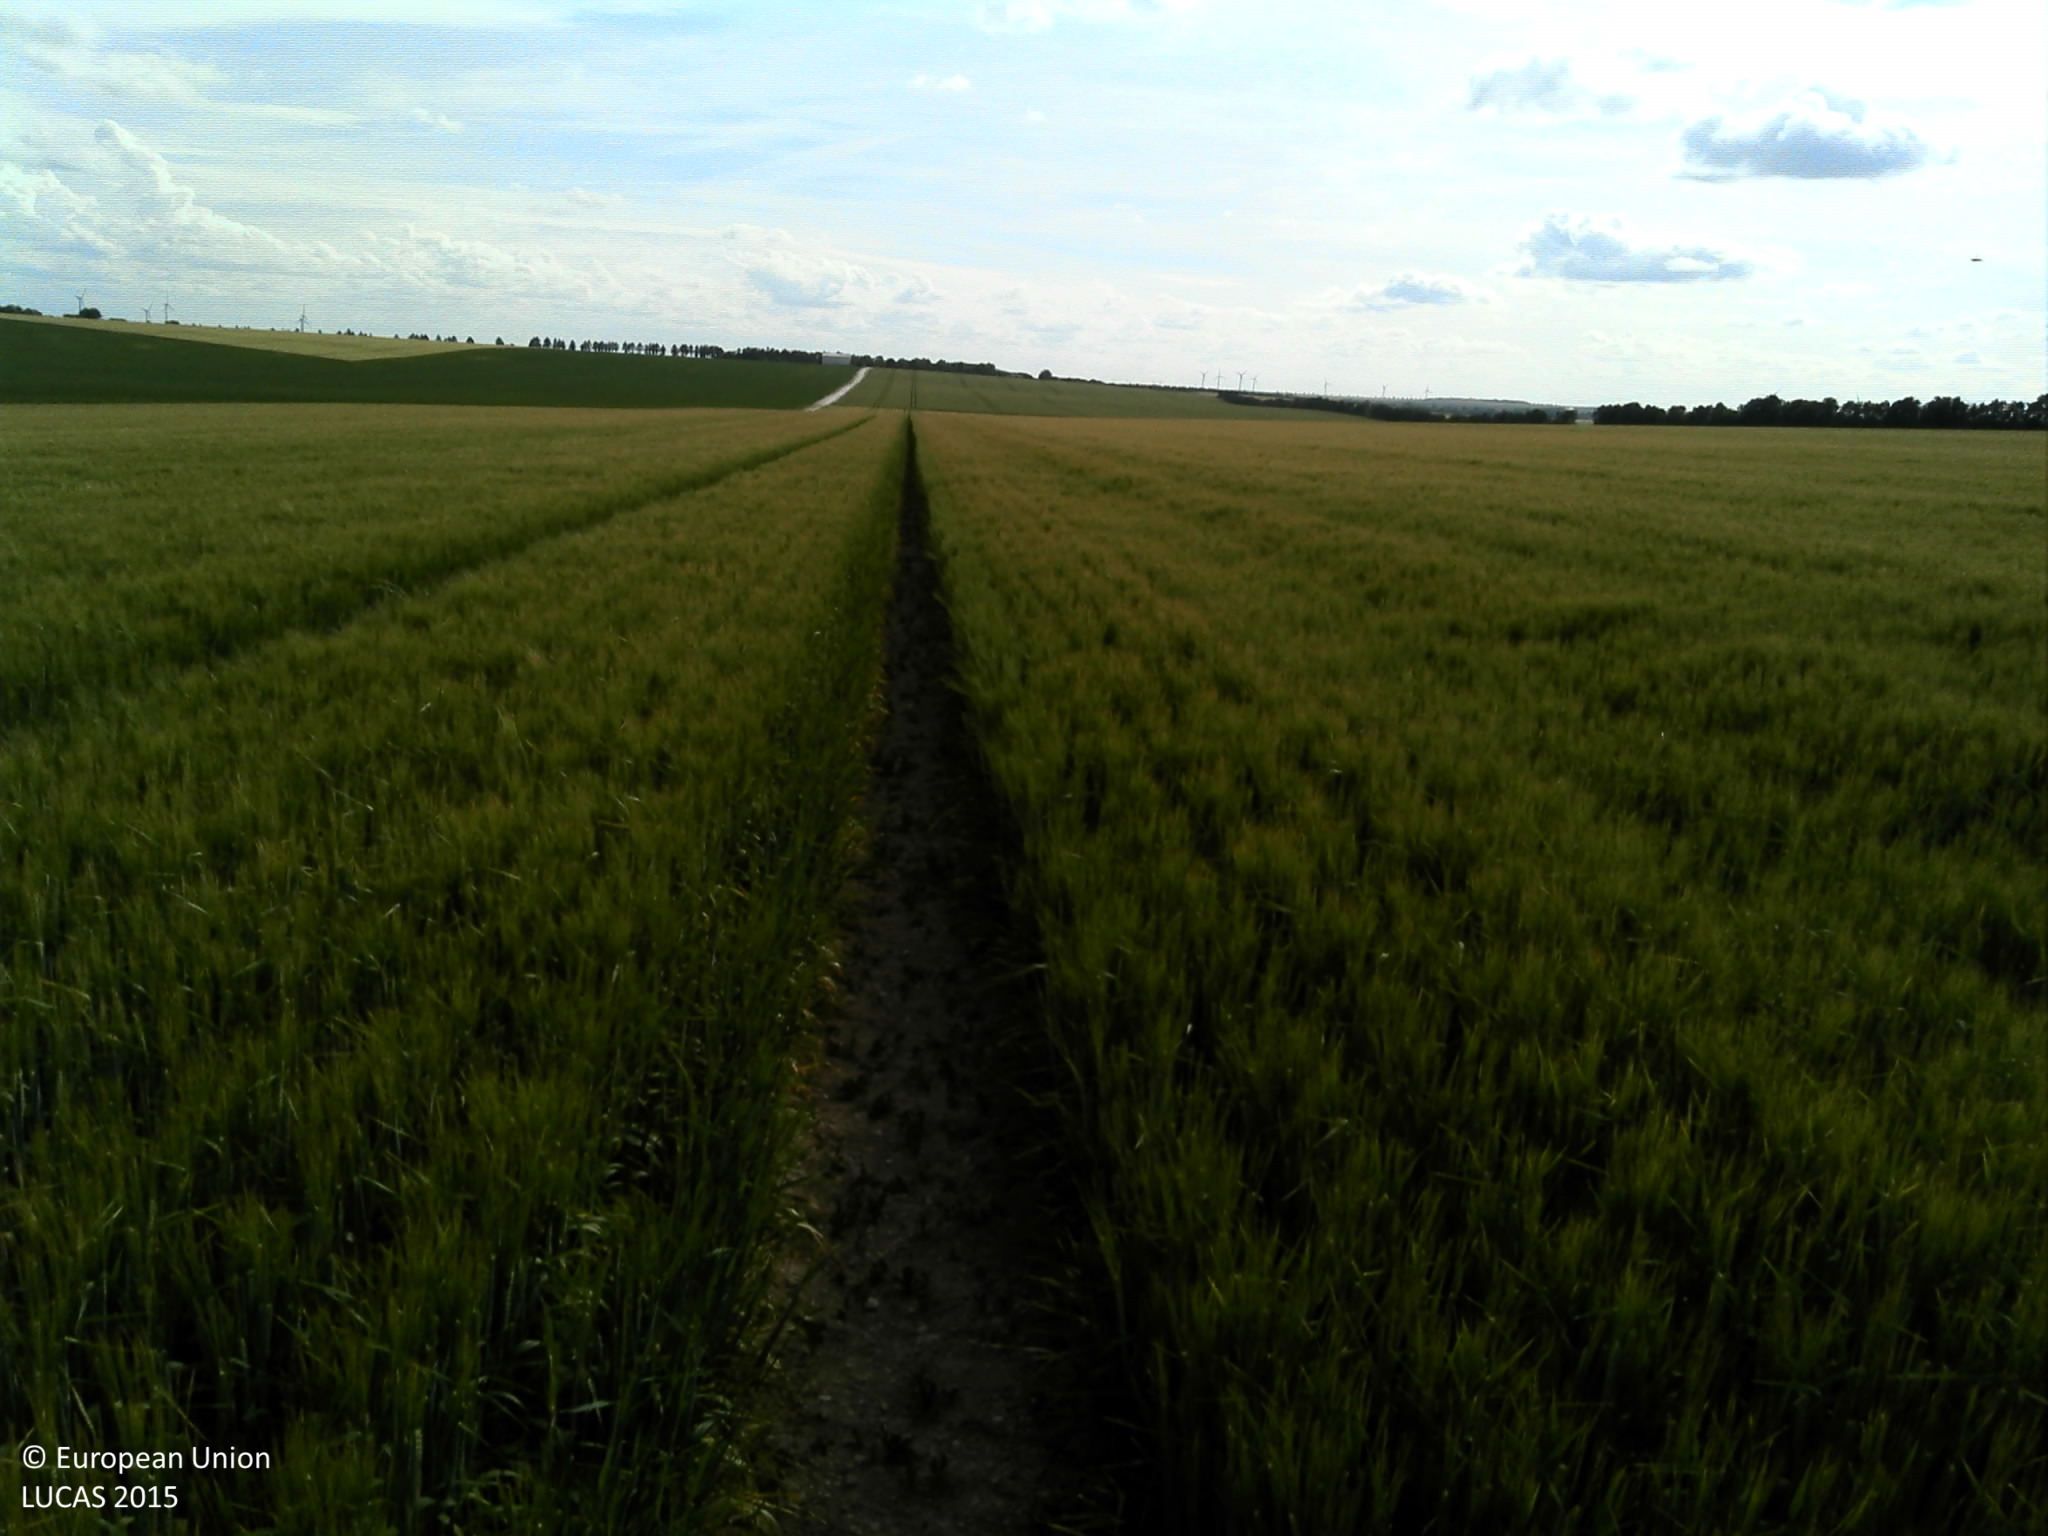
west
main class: Cropland
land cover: Barley
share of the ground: > 75 %
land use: Agriculture (excluding fallow land and kitchen gardens)
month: June
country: FR
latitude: 48.6467
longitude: 4.1733
